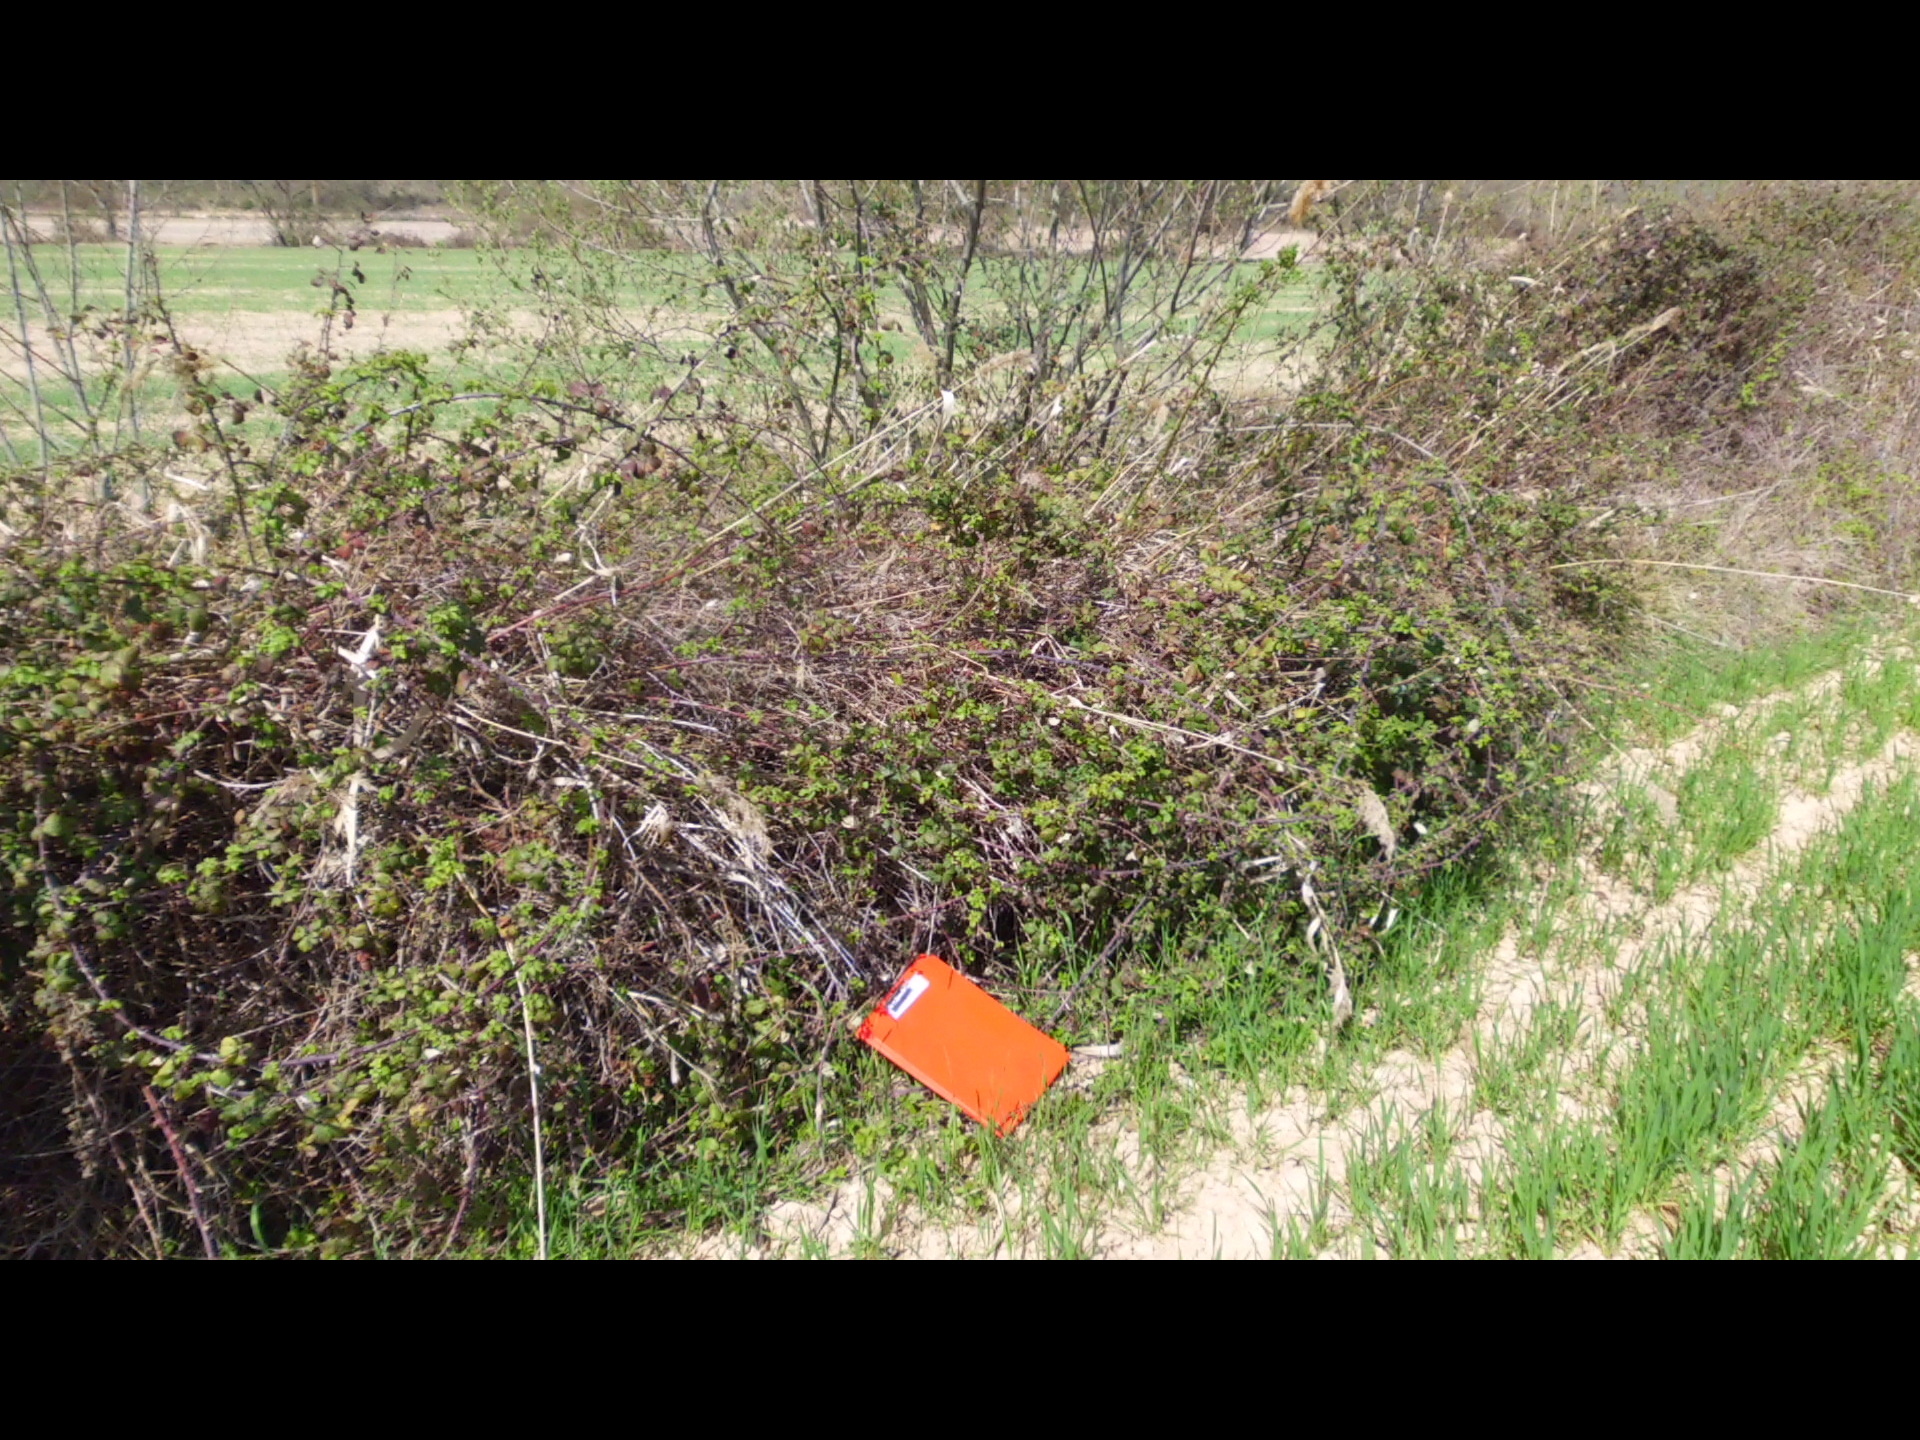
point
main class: Cropland
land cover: Common wheat
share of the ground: > 75 %
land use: Agriculture (excluding fallow land and kitchen gardens)
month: April
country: ES
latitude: 42.5607
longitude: -3.4205
